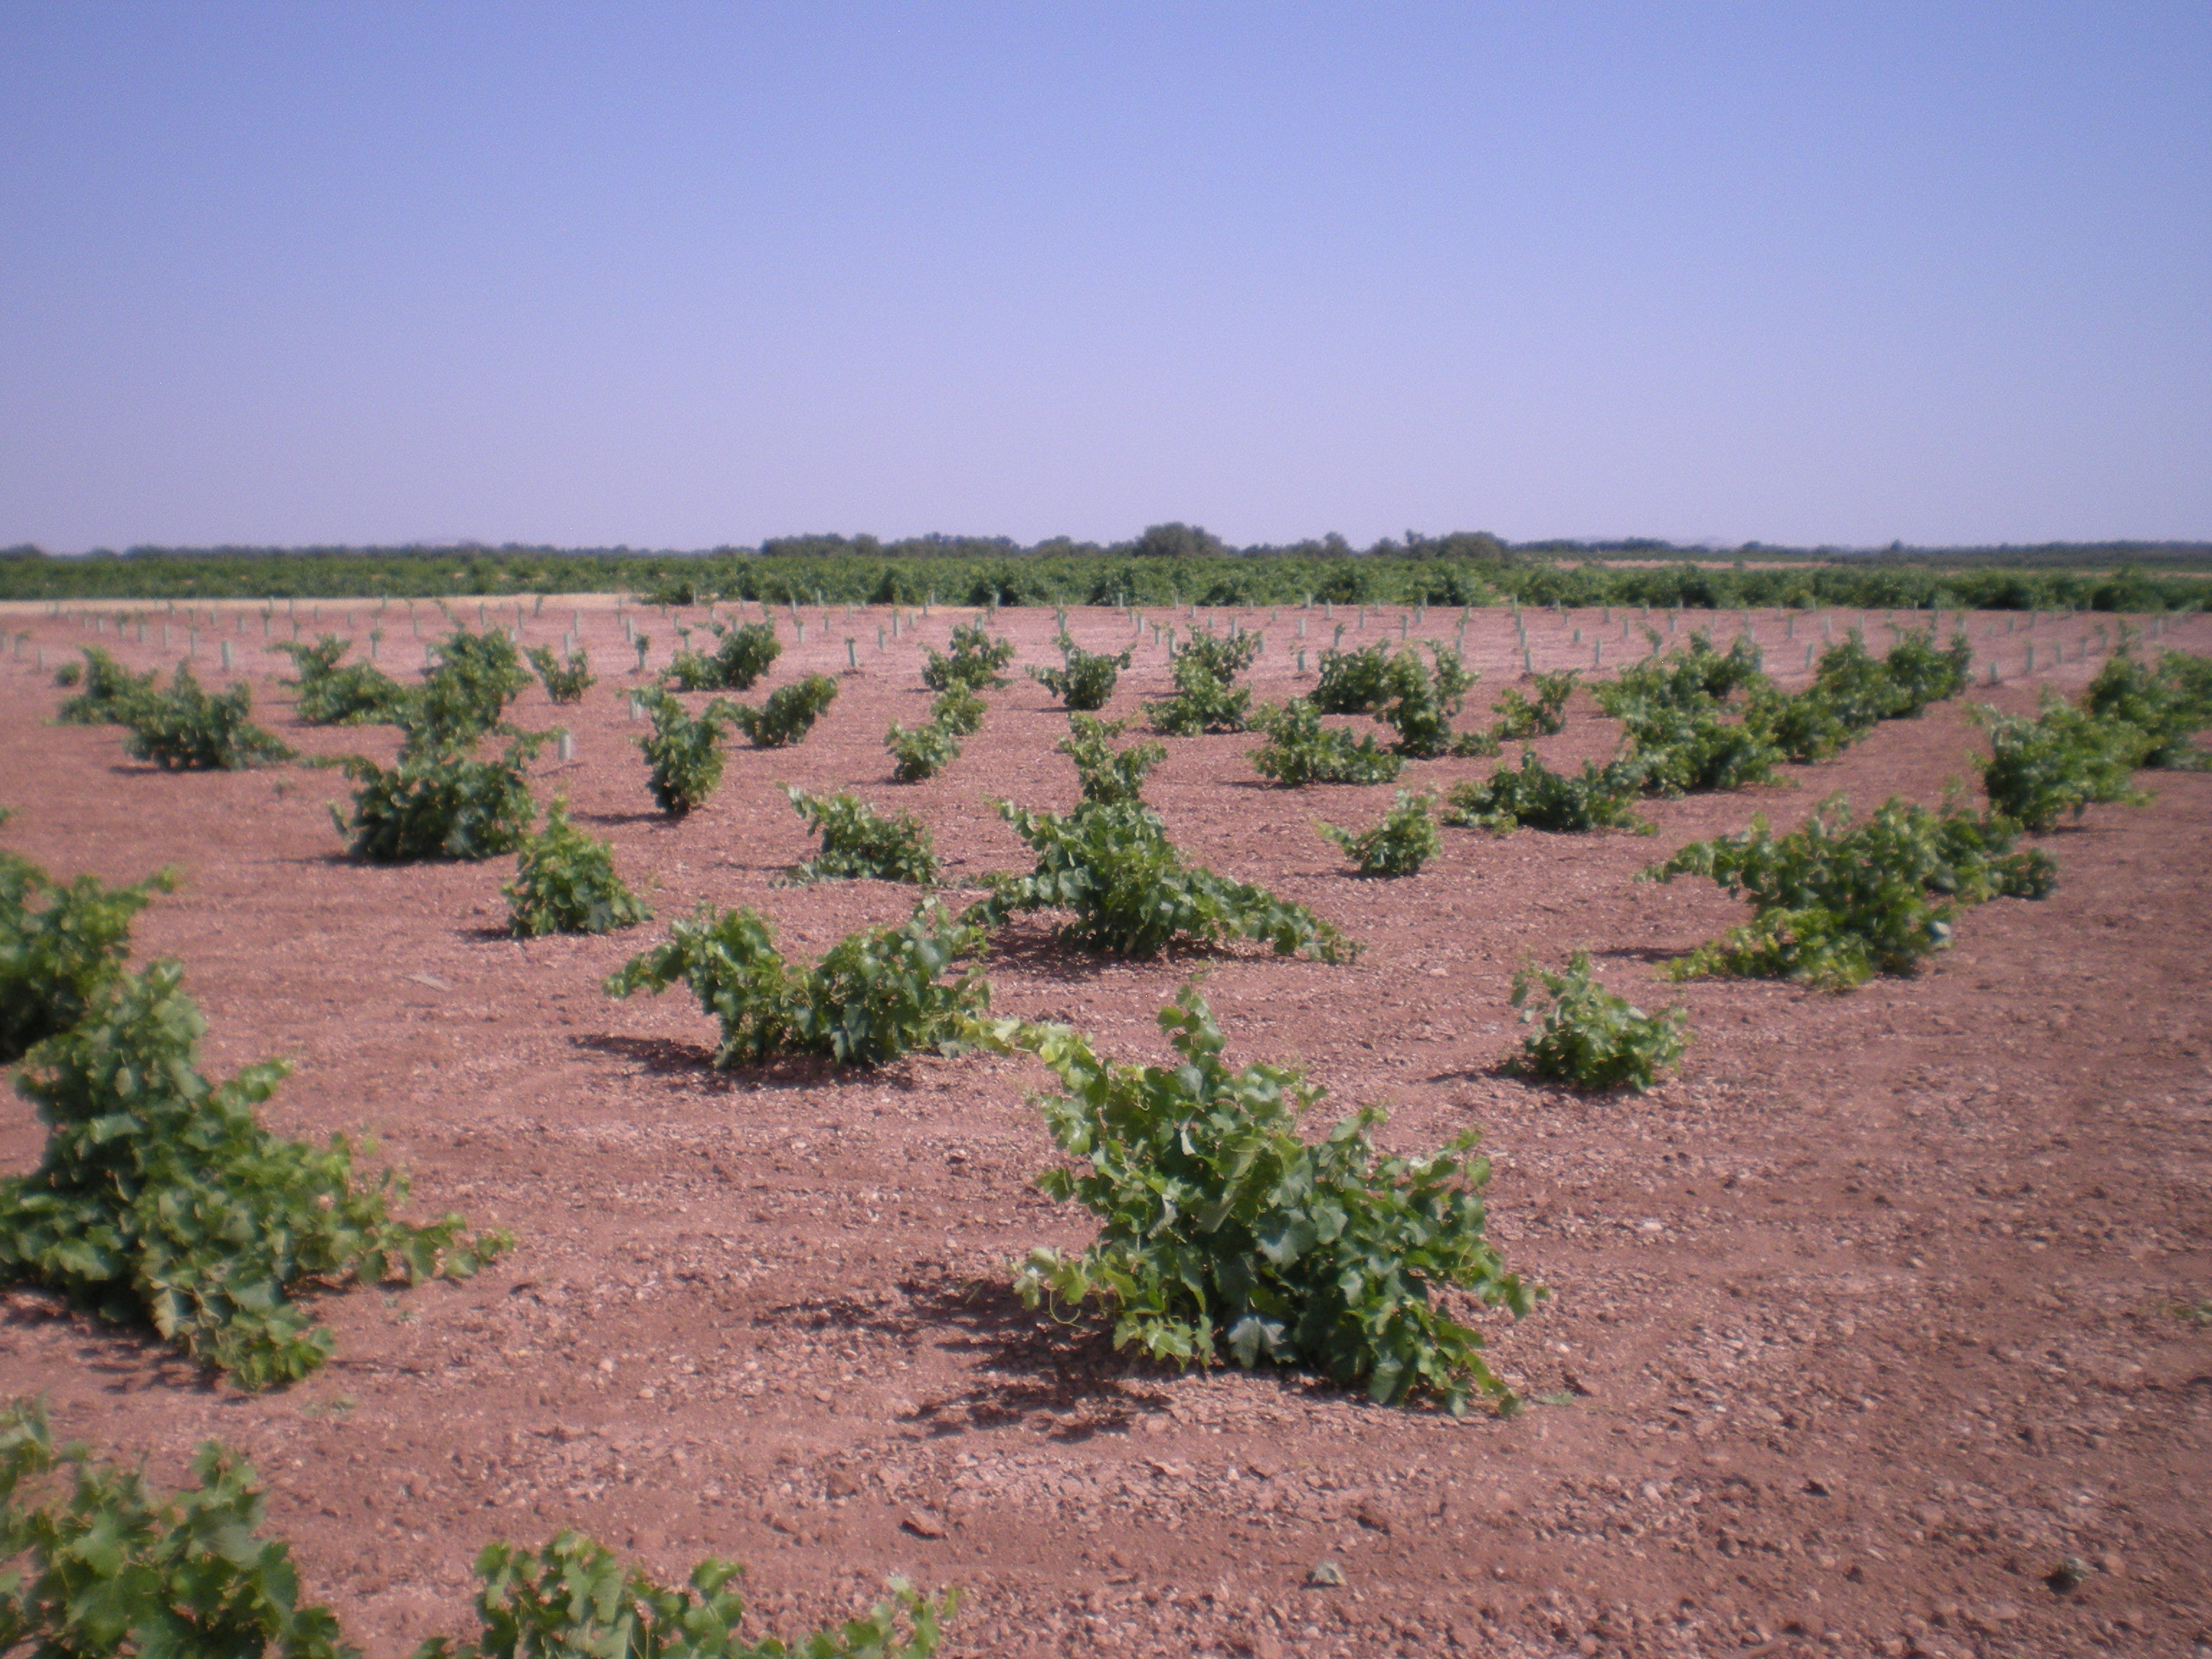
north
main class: Cropland
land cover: Vineyards
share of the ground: < 10 %
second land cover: Other bare soil
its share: > 75 %
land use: Agriculture (excluding fallow land and kitchen gardens)
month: June
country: ES
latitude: 39.6038
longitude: -3.2396
